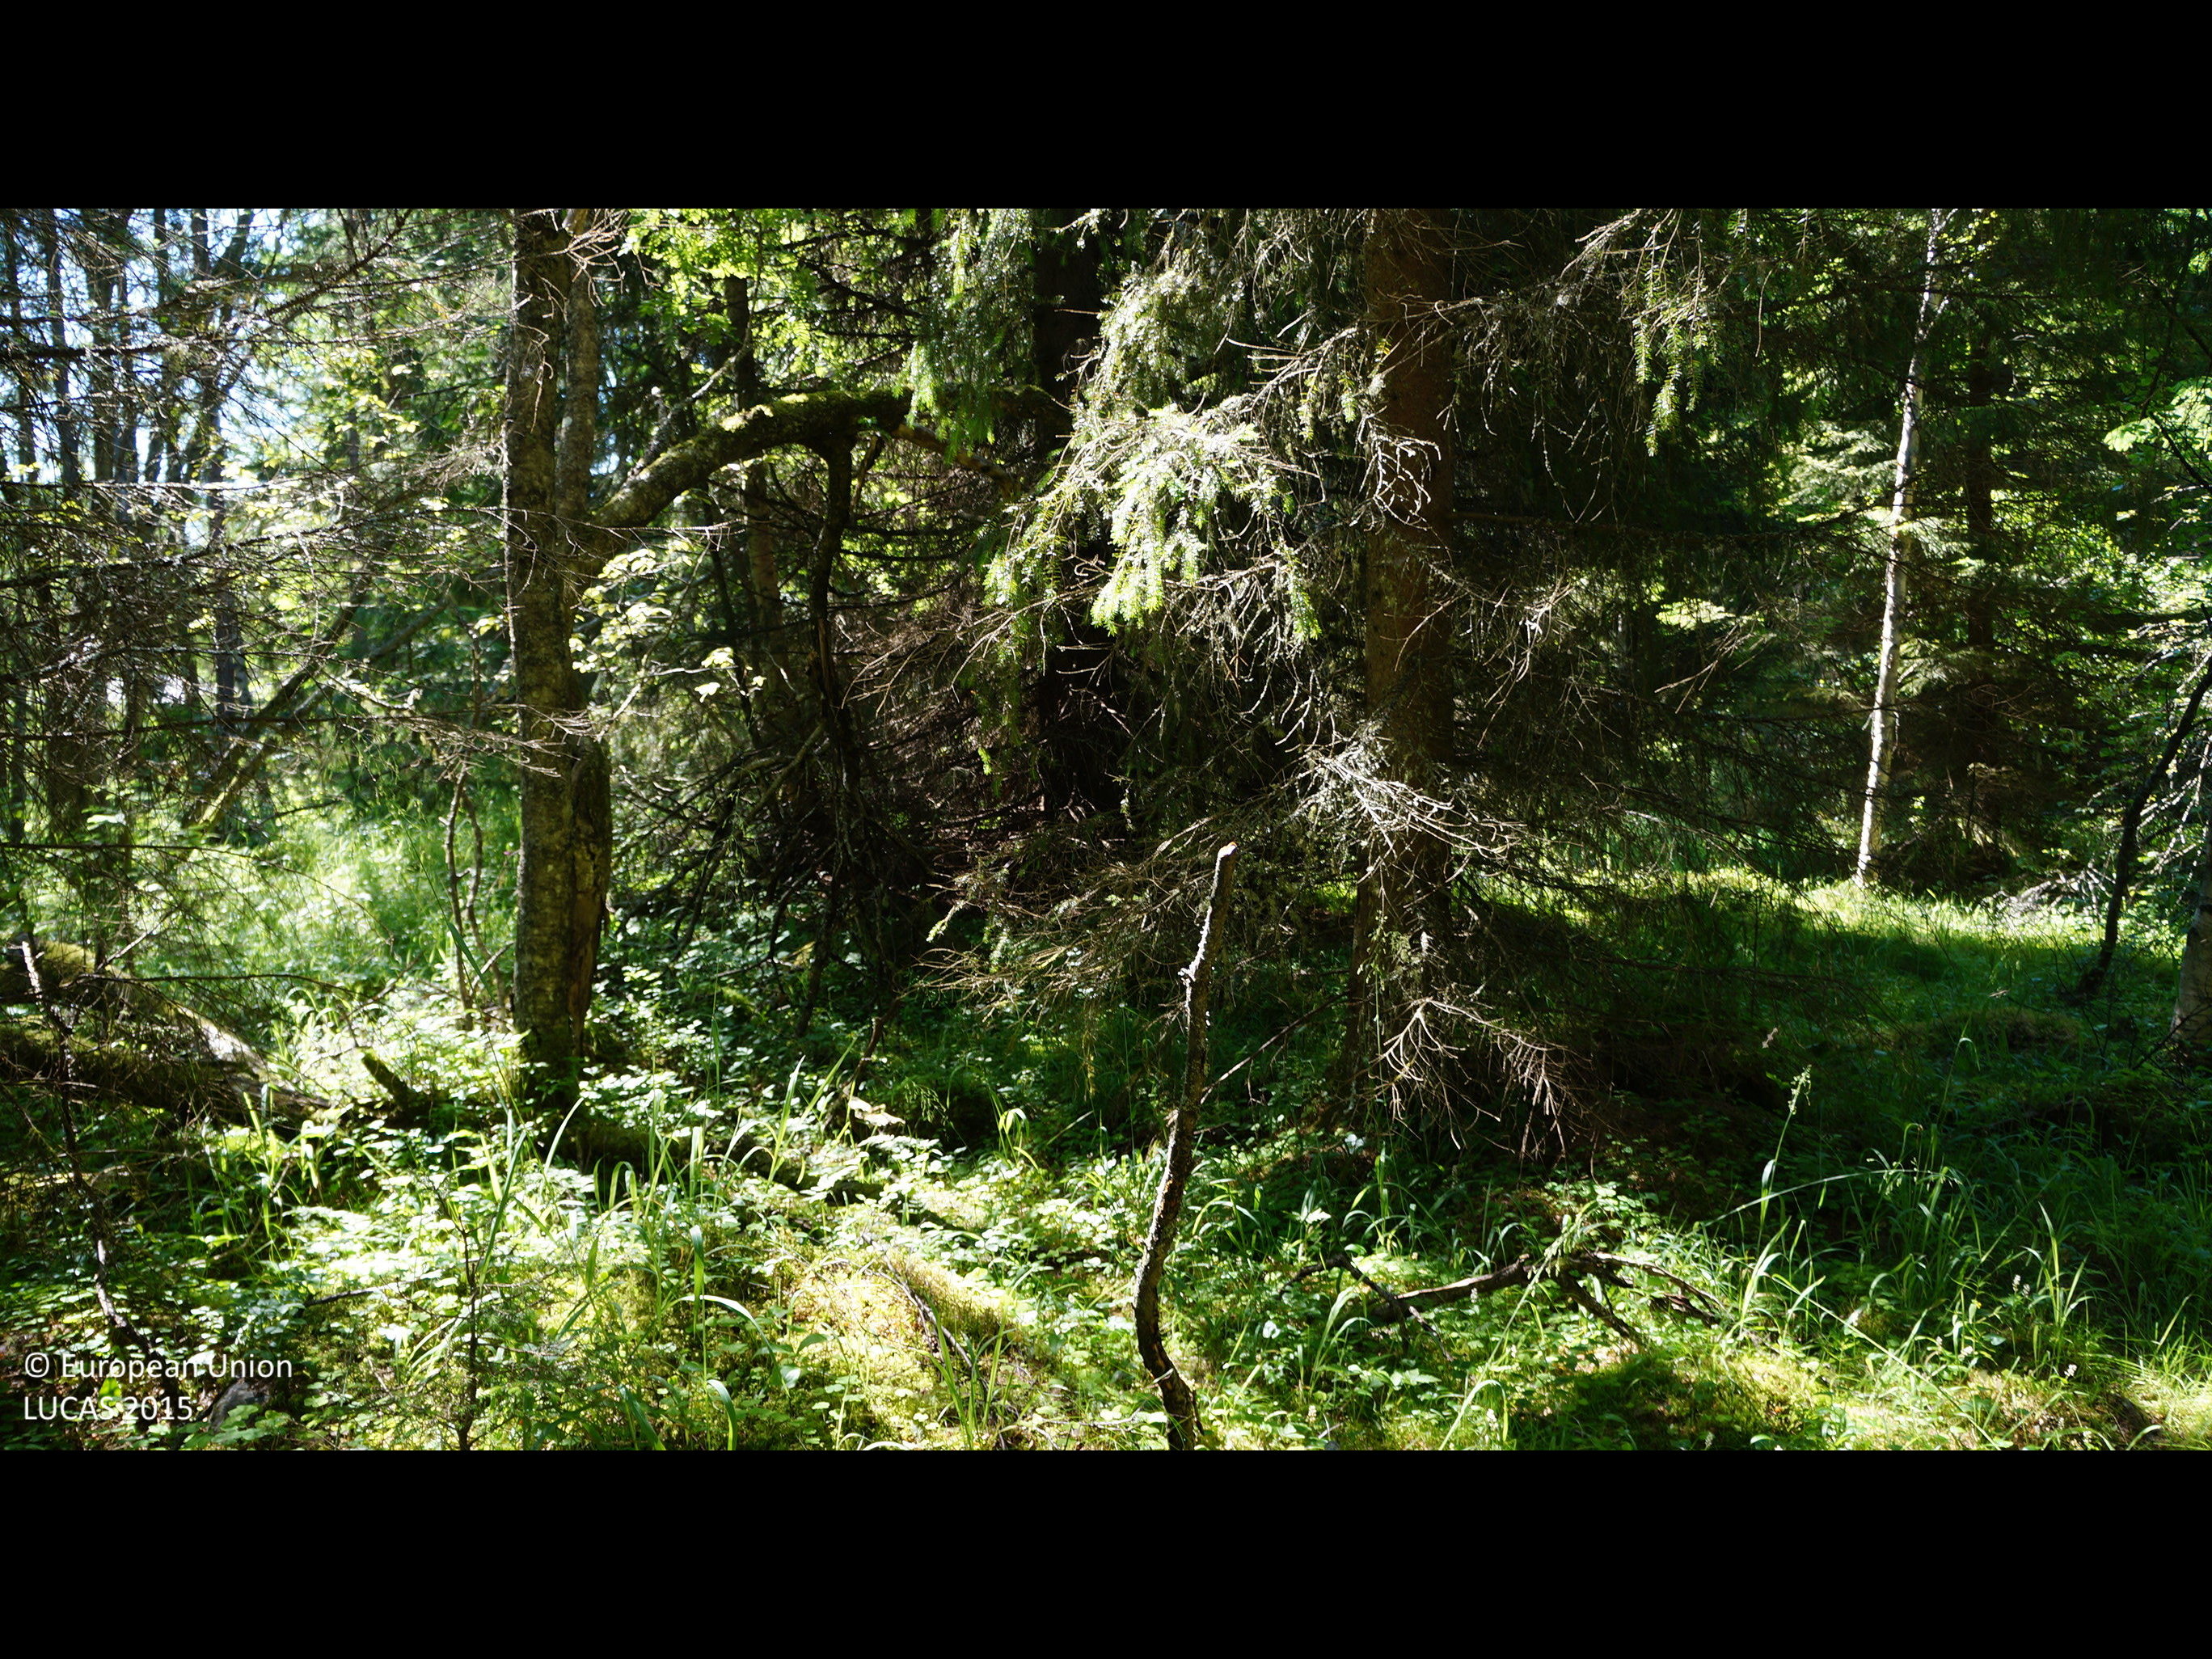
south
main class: Woodland
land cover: Spruce dominated mixed woodland
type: boreal forest
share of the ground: 50 - 75 %
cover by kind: coniferous forest trees 40 %, broadleaved forest trees 30 %, herbaceous plants 15 %, shrubs 10 %, lichens and mosses 5 %
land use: Forestry
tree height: > 5 m
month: July
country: FI
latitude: 63.8312
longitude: 22.9145
